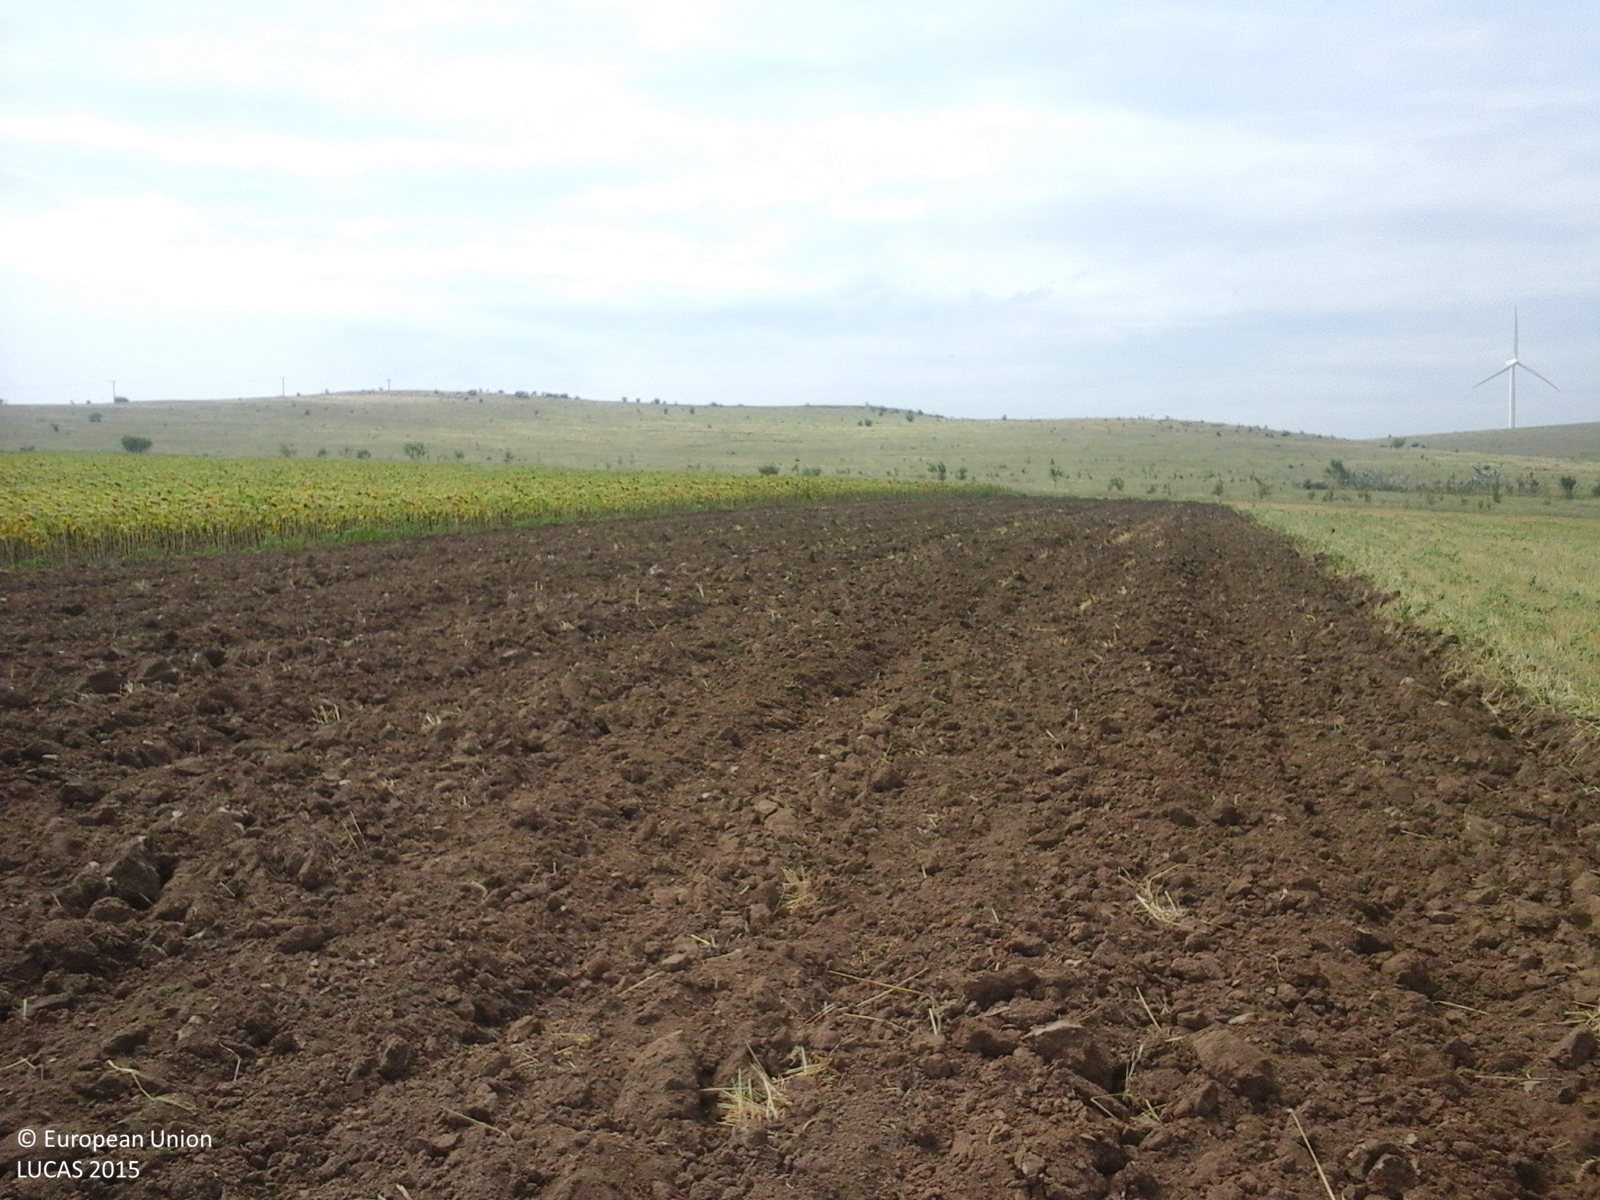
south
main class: Cropland
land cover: Common wheat
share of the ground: < 10 %
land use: Agriculture (excluding fallow land and kitchen gardens)
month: August
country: RO
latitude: 44.8929
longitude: 28.7628
